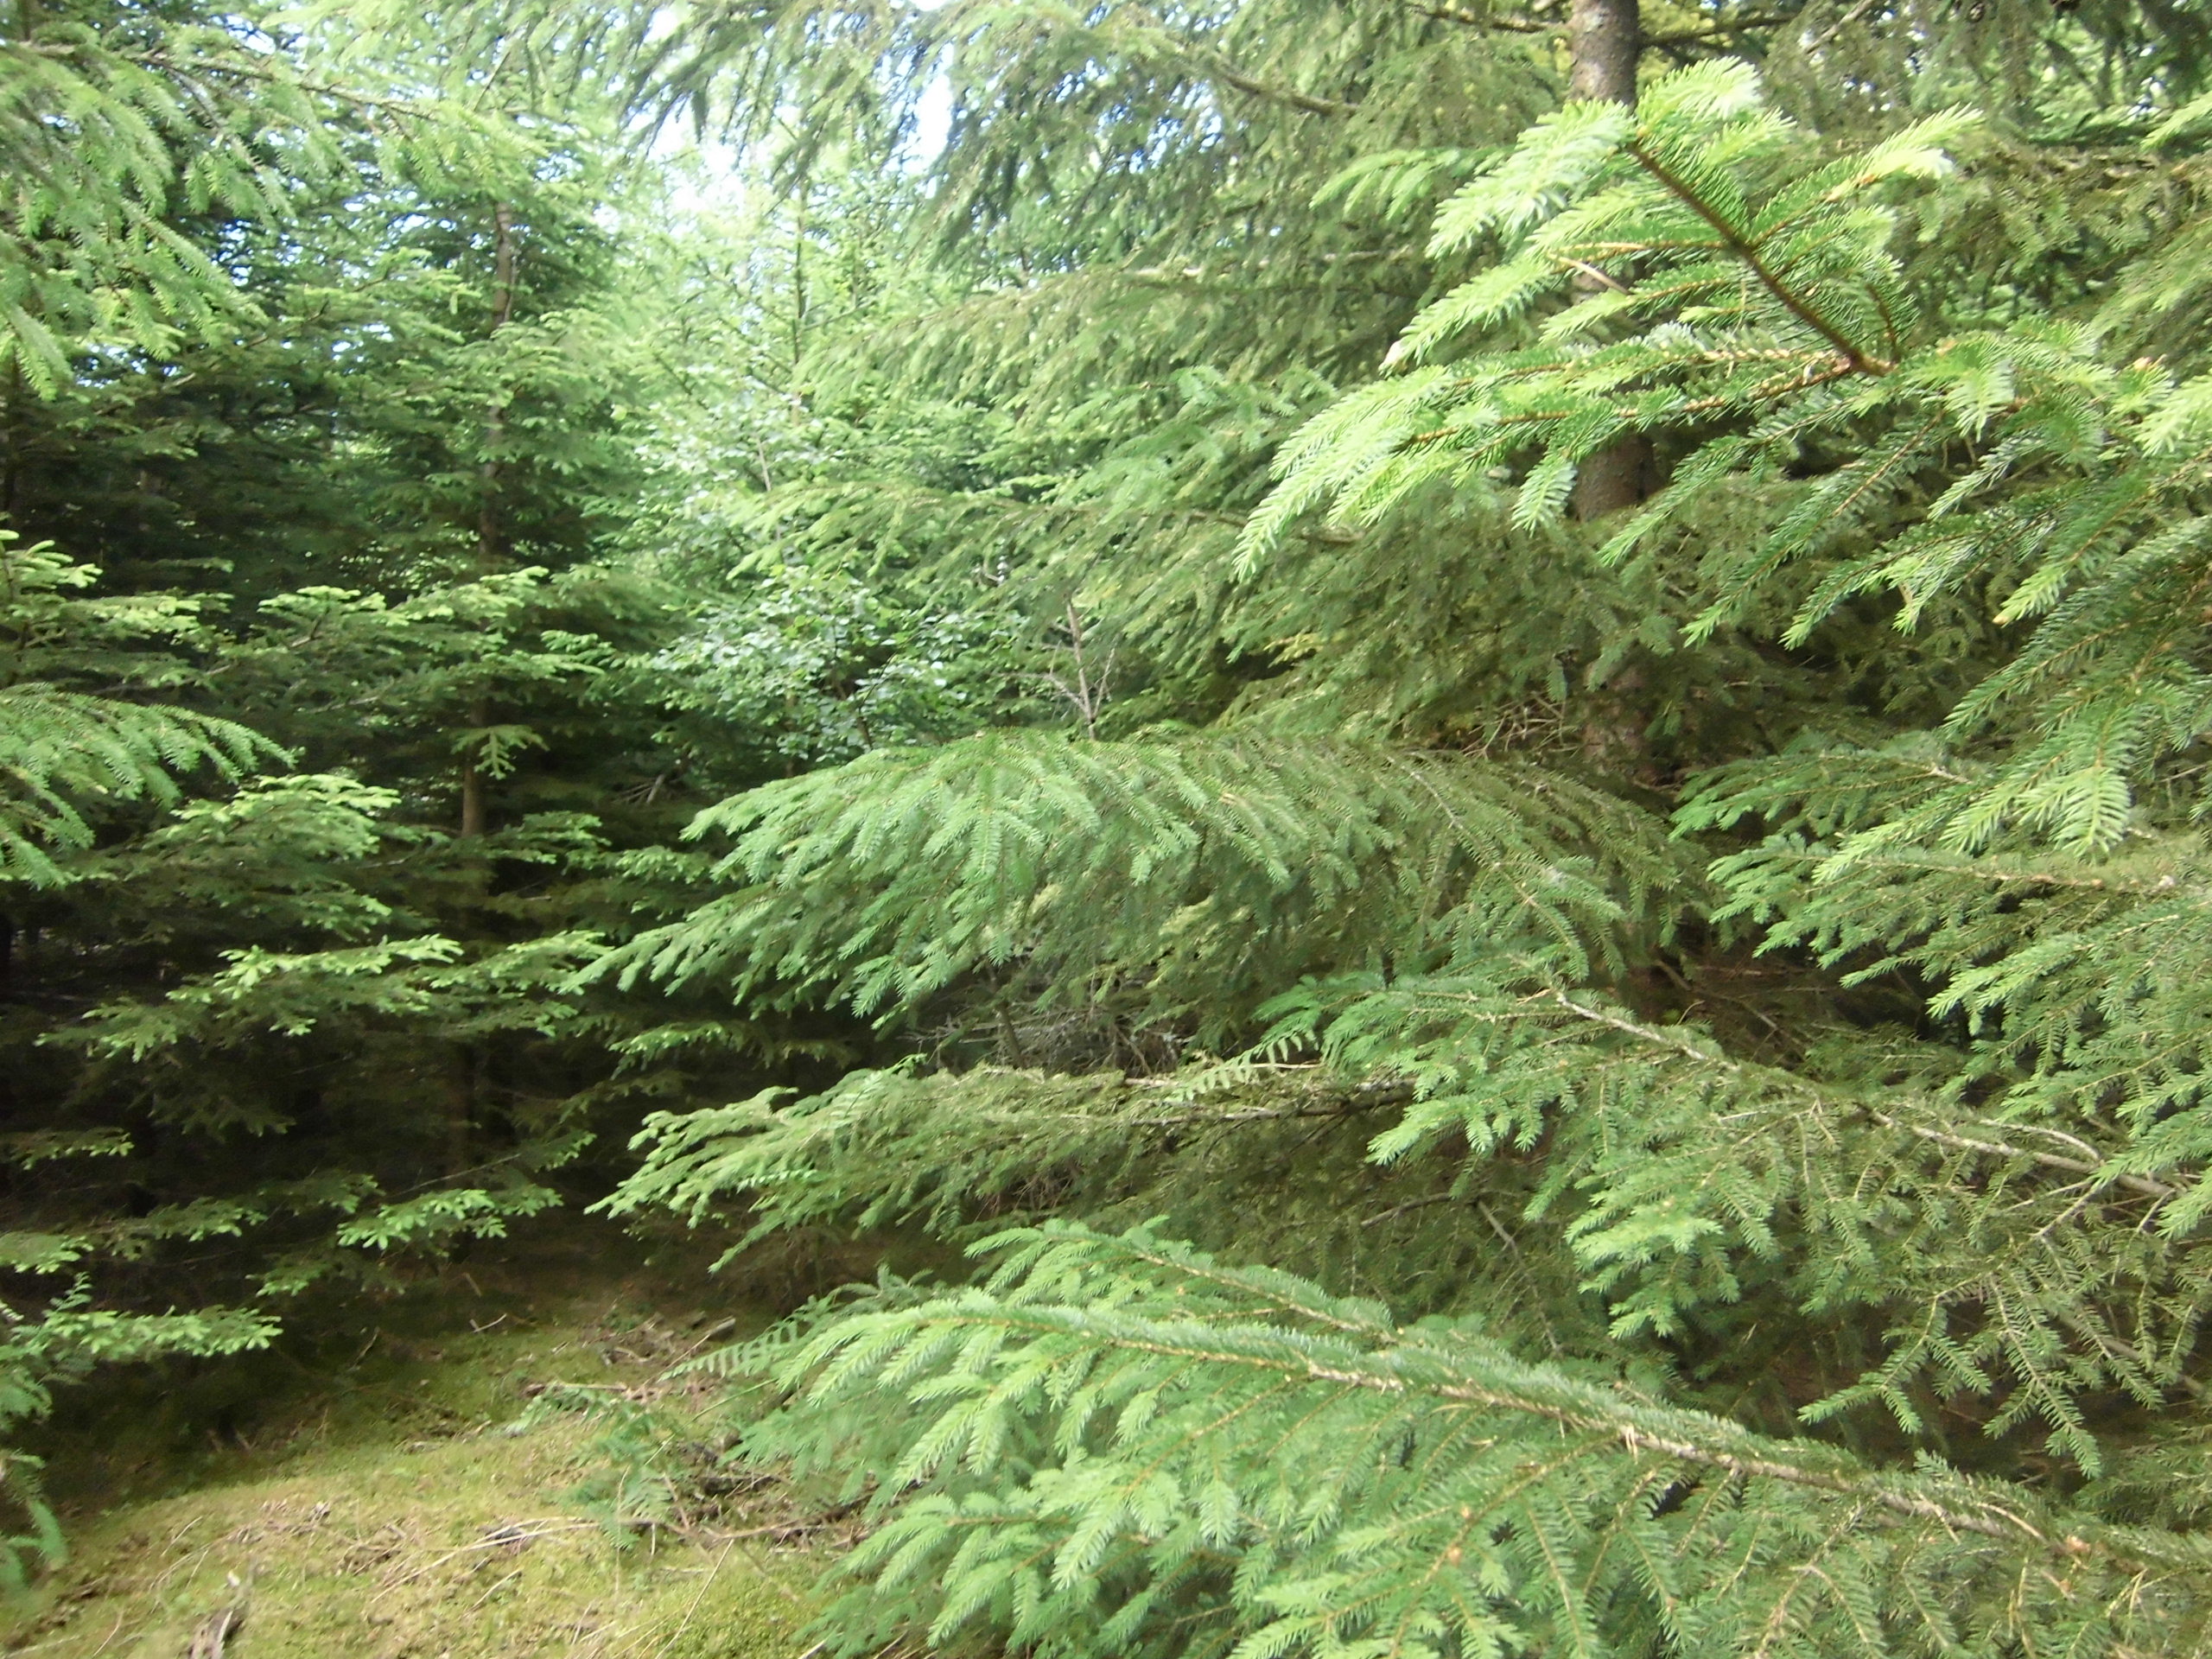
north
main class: Woodland
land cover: Spruce dominated coniferous woodland
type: boreal forest
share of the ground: > 75 %
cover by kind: coniferous forest trees 75 %, lichens and mosses 15 %, broadleaved forest trees 5 %, herbaceous plants 5 %
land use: Forestry
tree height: > 5 m
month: July
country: SE
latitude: 57.2465
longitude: 14.9186
